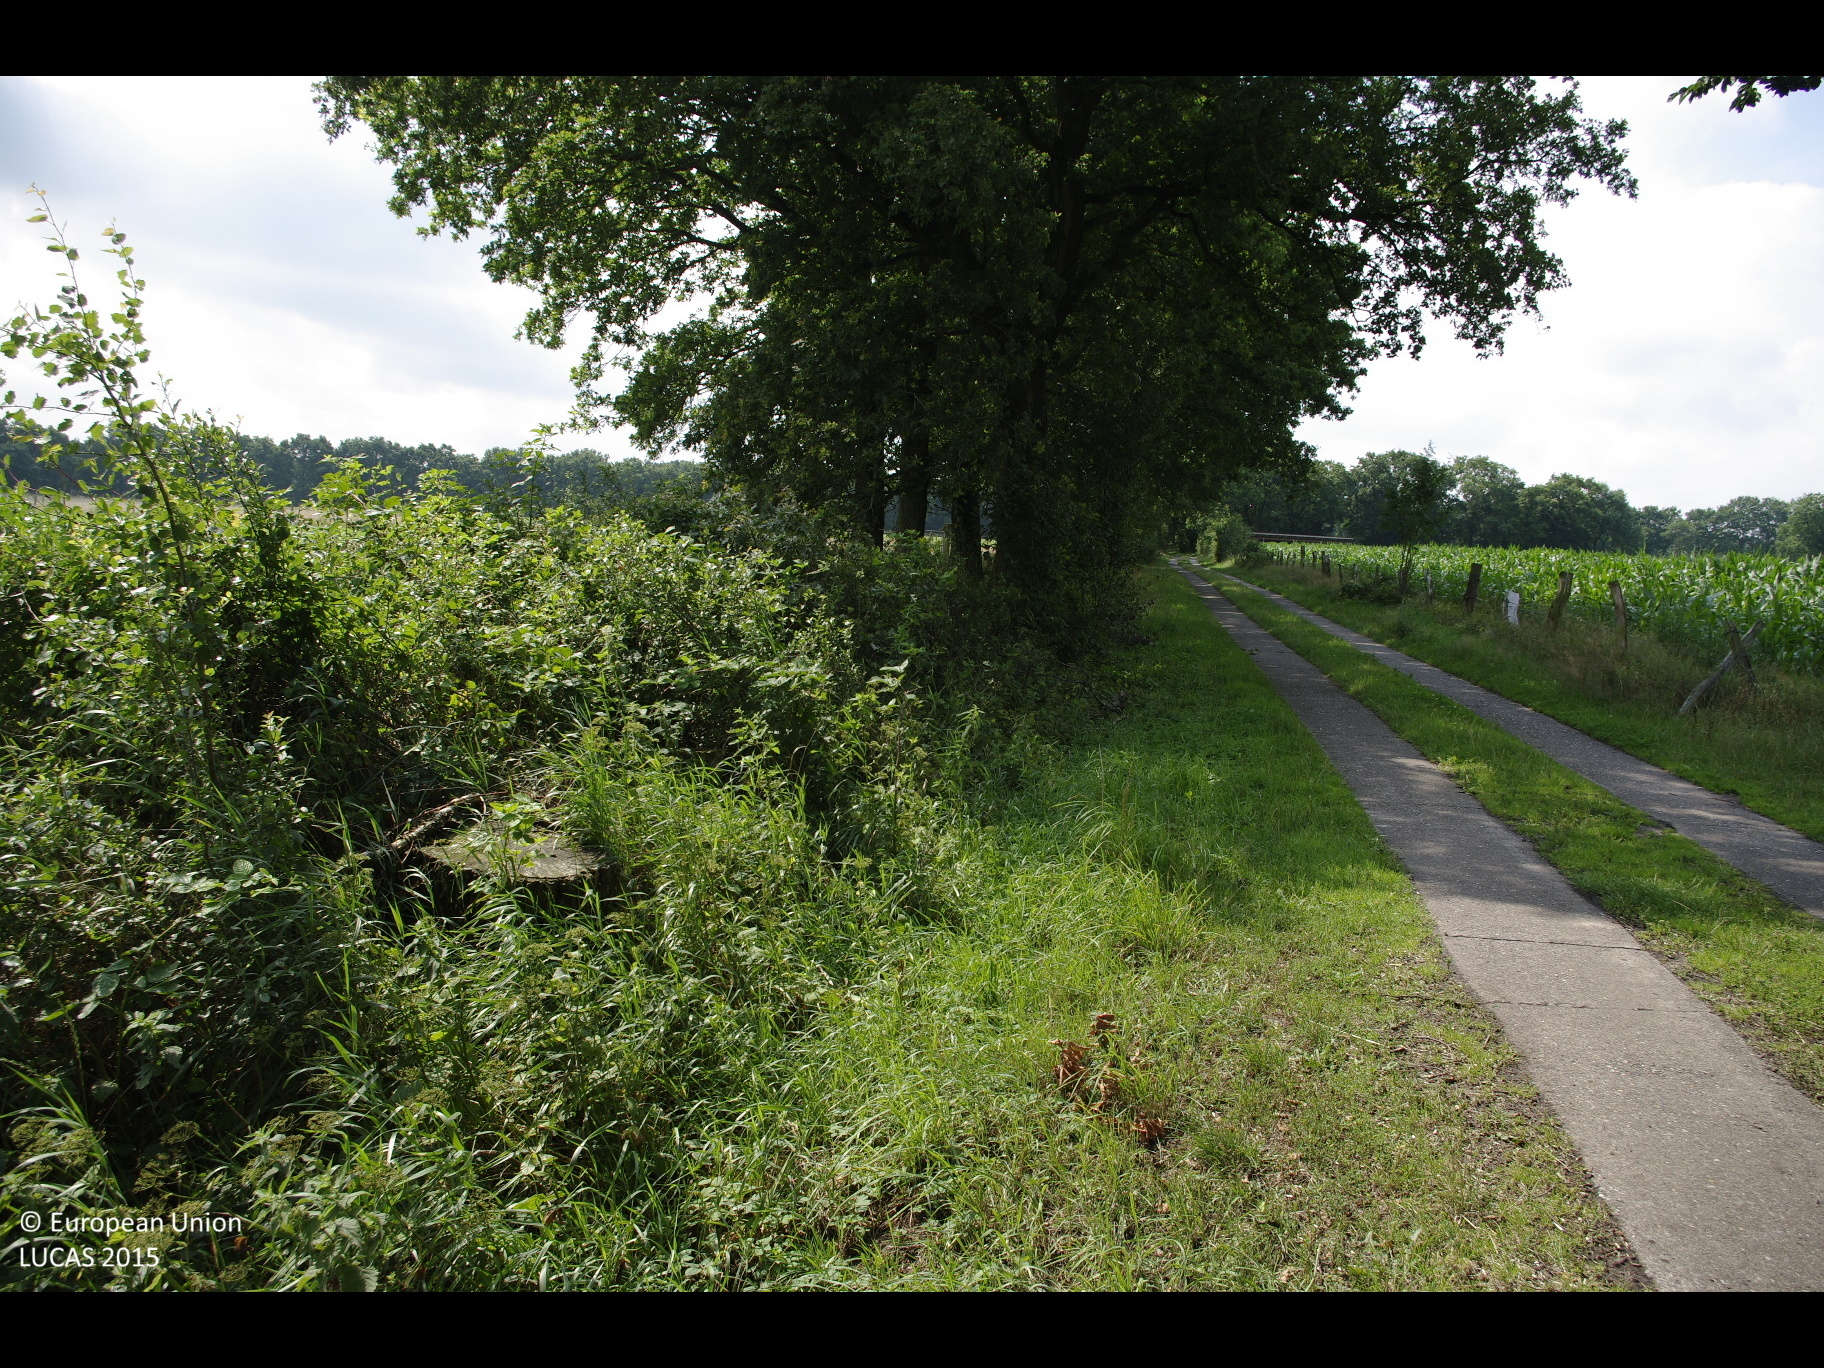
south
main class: Cropland
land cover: Maize
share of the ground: > 75 %
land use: Agriculture (excluding fallow land and kitchen gardens)
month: July
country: DE
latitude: 53.8871
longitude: 9.9544
